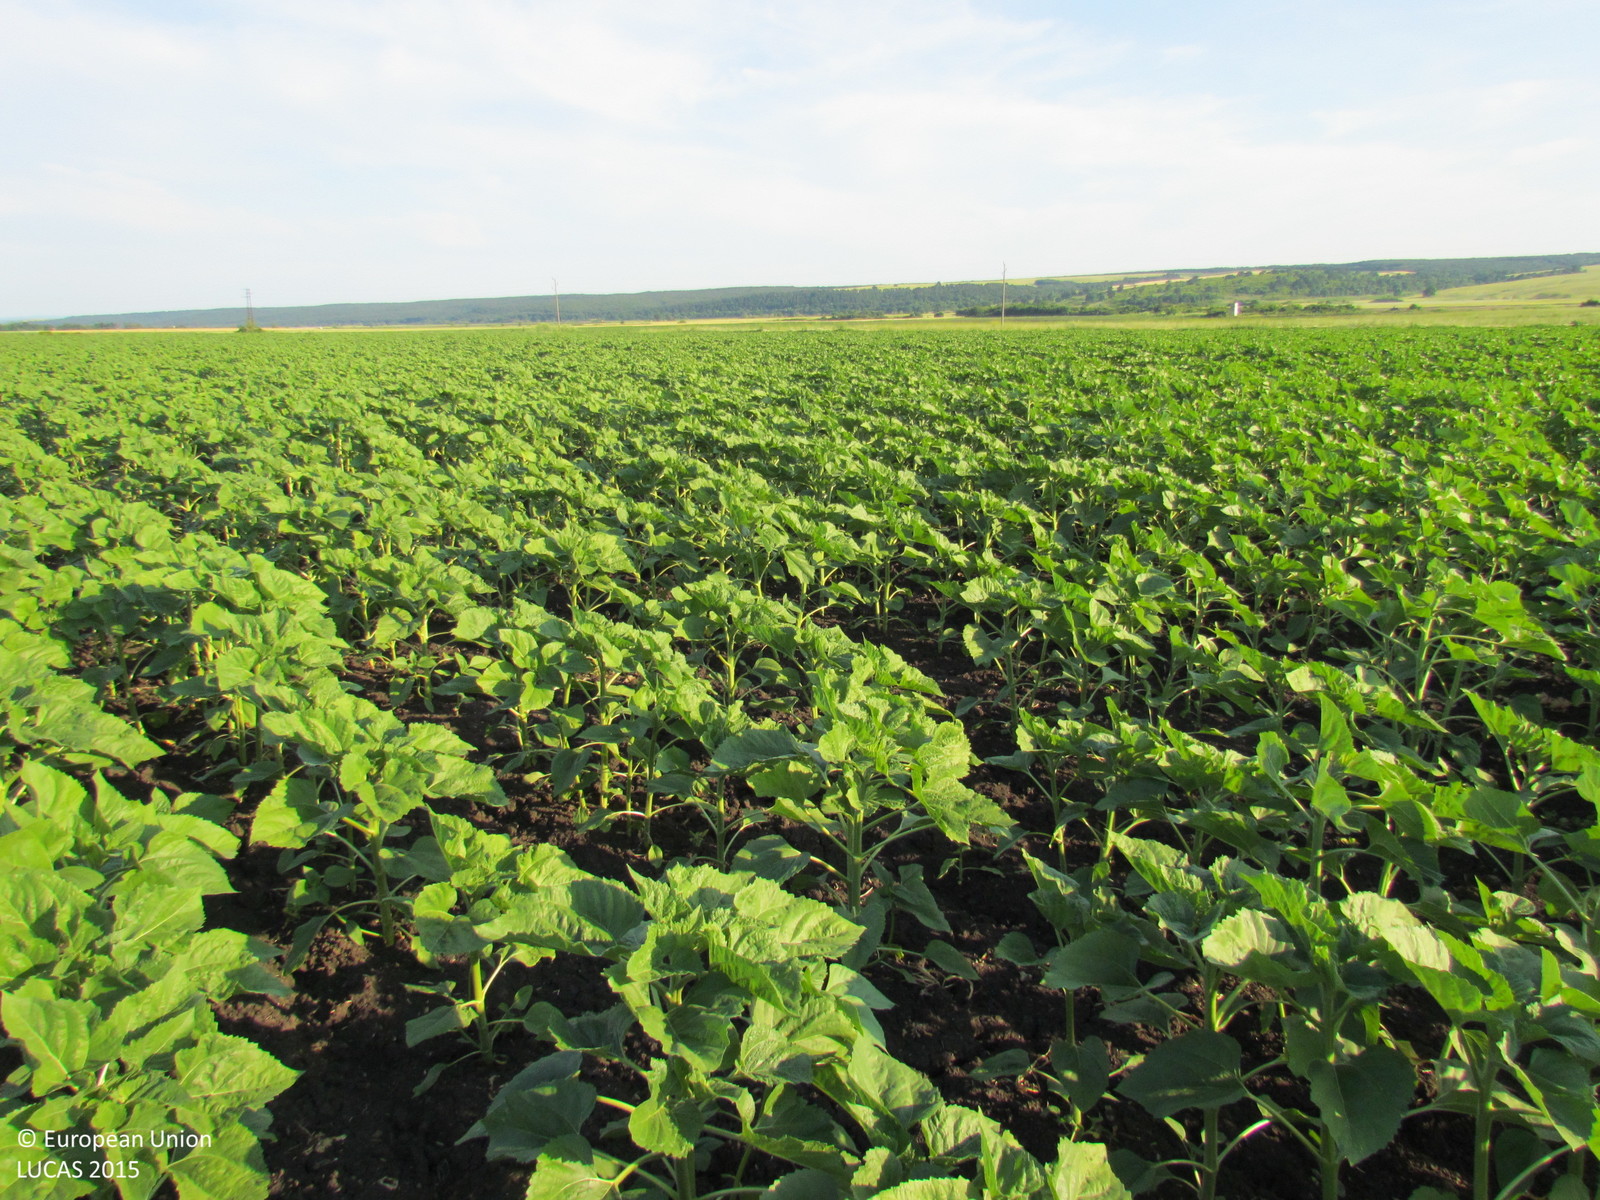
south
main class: Cropland
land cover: Sunflower
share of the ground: > 75 %
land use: Agriculture (excluding fallow land and kitchen gardens)
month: June
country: BG
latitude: 42.4600
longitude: 27.1950
